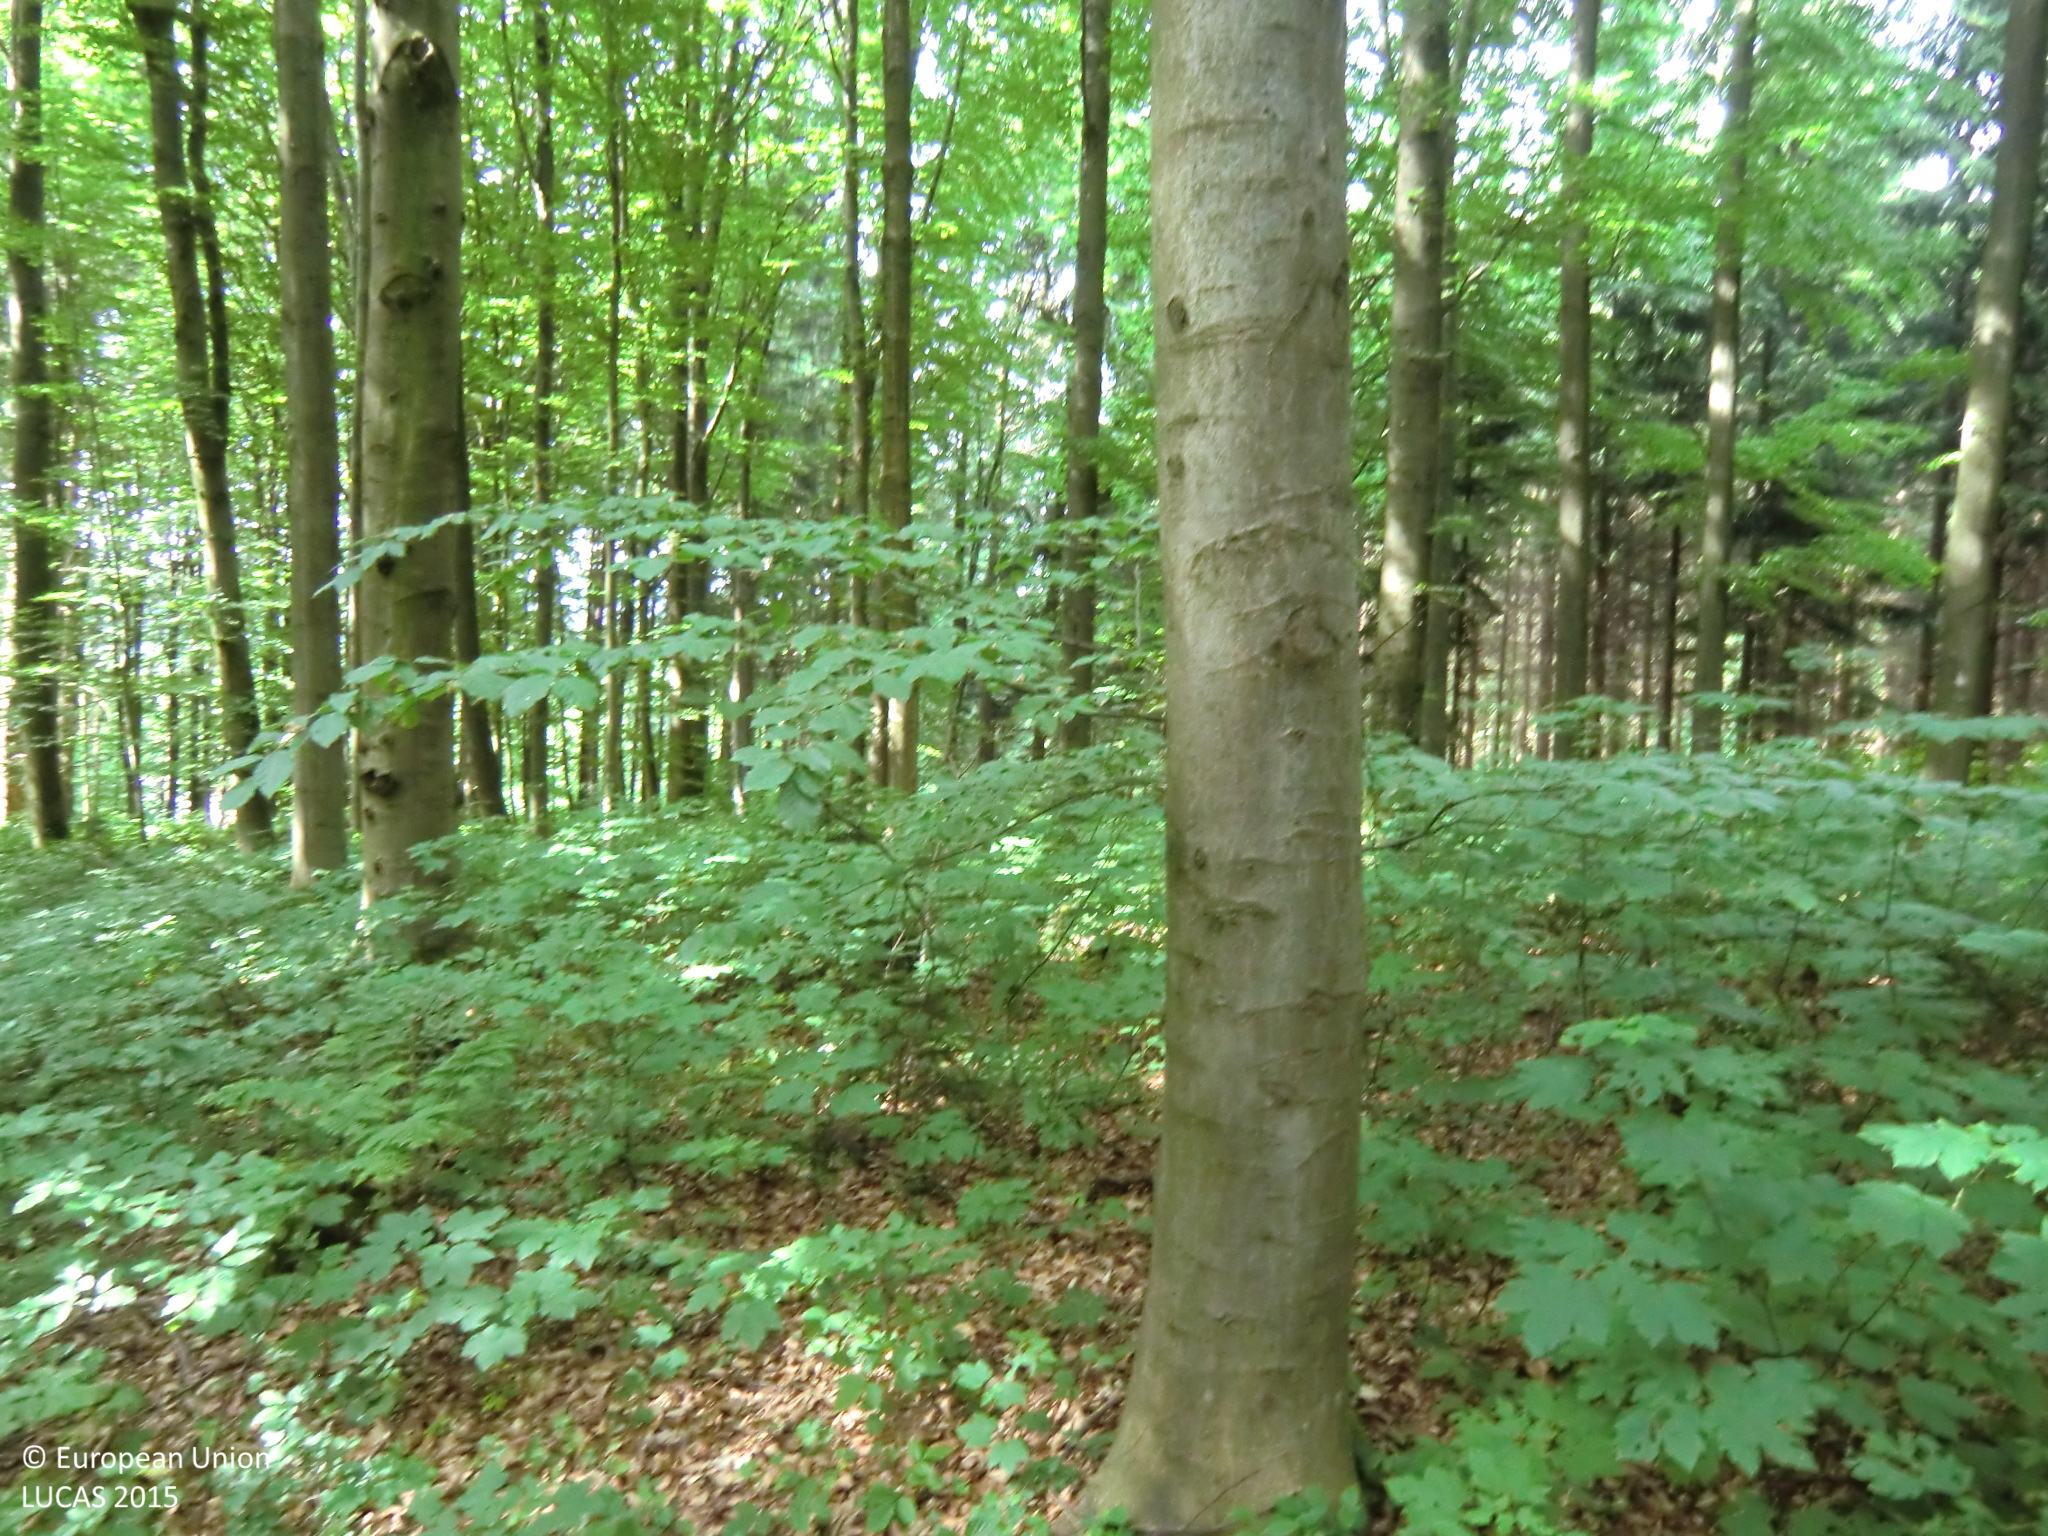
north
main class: Woodland
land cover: Spruce dominated mixed woodland
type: hemiboreal forest and nemoral coniferous forest and mixed broadleaved-coniferous forest
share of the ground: > 75 %
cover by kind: coniferous forest trees 45 %, broadleaved forest trees 45 %, shrubs 5 %, herbaceous plants 5 %
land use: Forestry
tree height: > 5 m
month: May
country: AT
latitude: 48.2161
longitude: 15.0483
